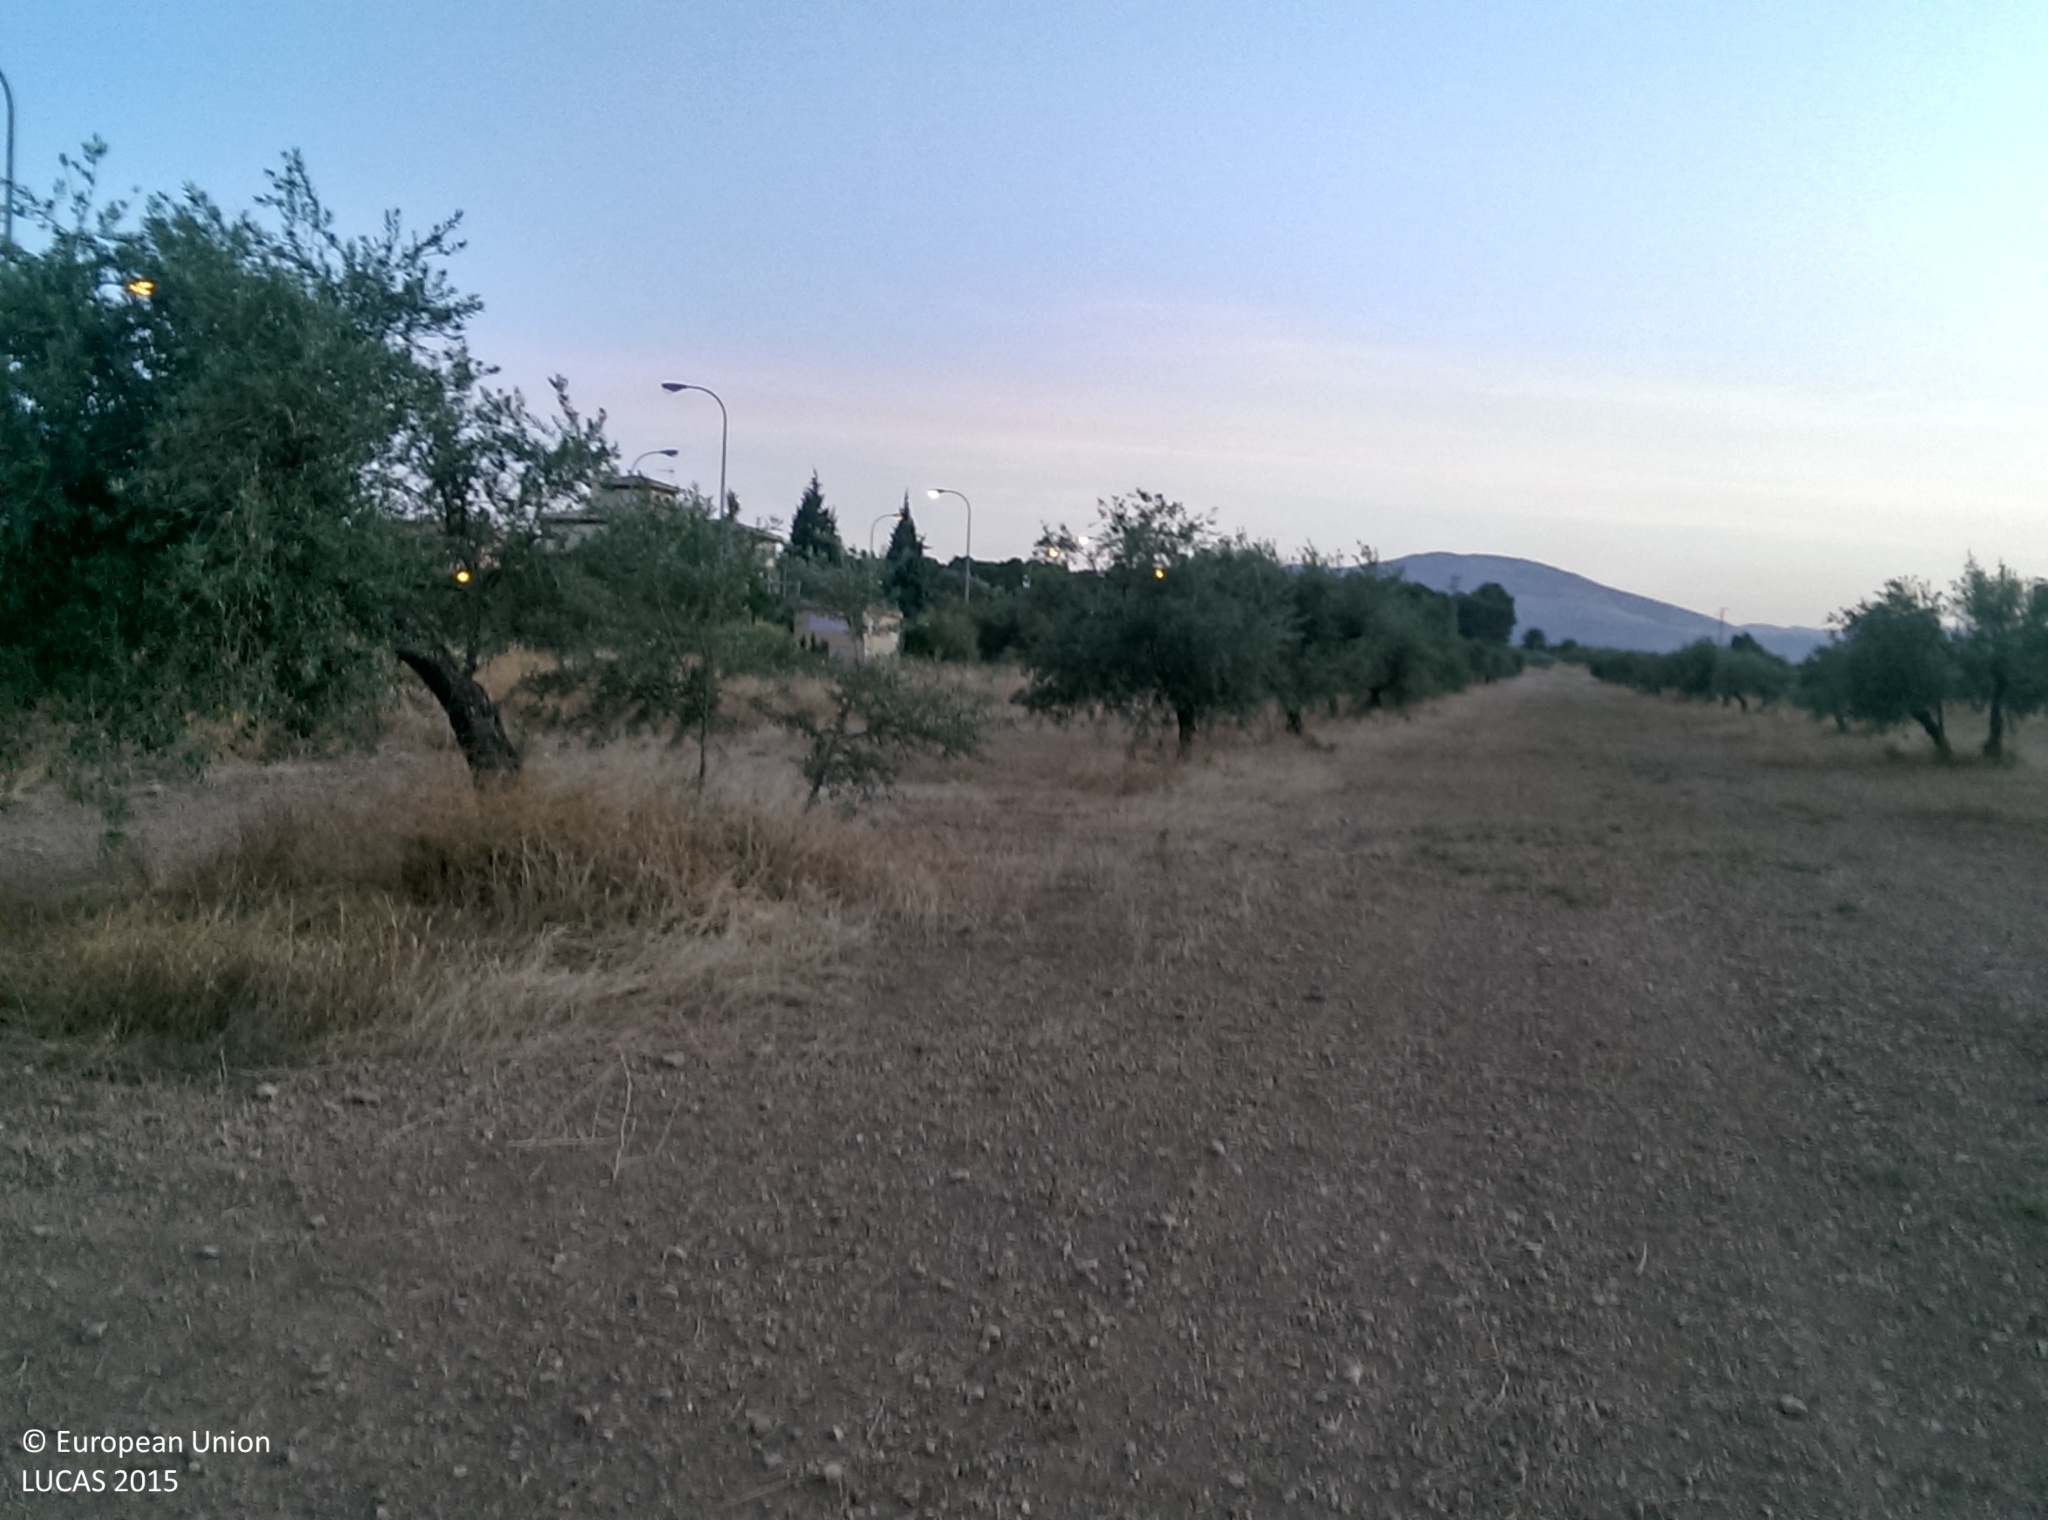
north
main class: Cropland
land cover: Olive groves
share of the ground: 10 - 25 %
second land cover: Other bare soil
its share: > 75 %
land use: Agriculture (excluding fallow land and kitchen gardens)
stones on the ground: 10 - 25 %
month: July
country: ES
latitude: 37.2873
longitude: -3.6739
